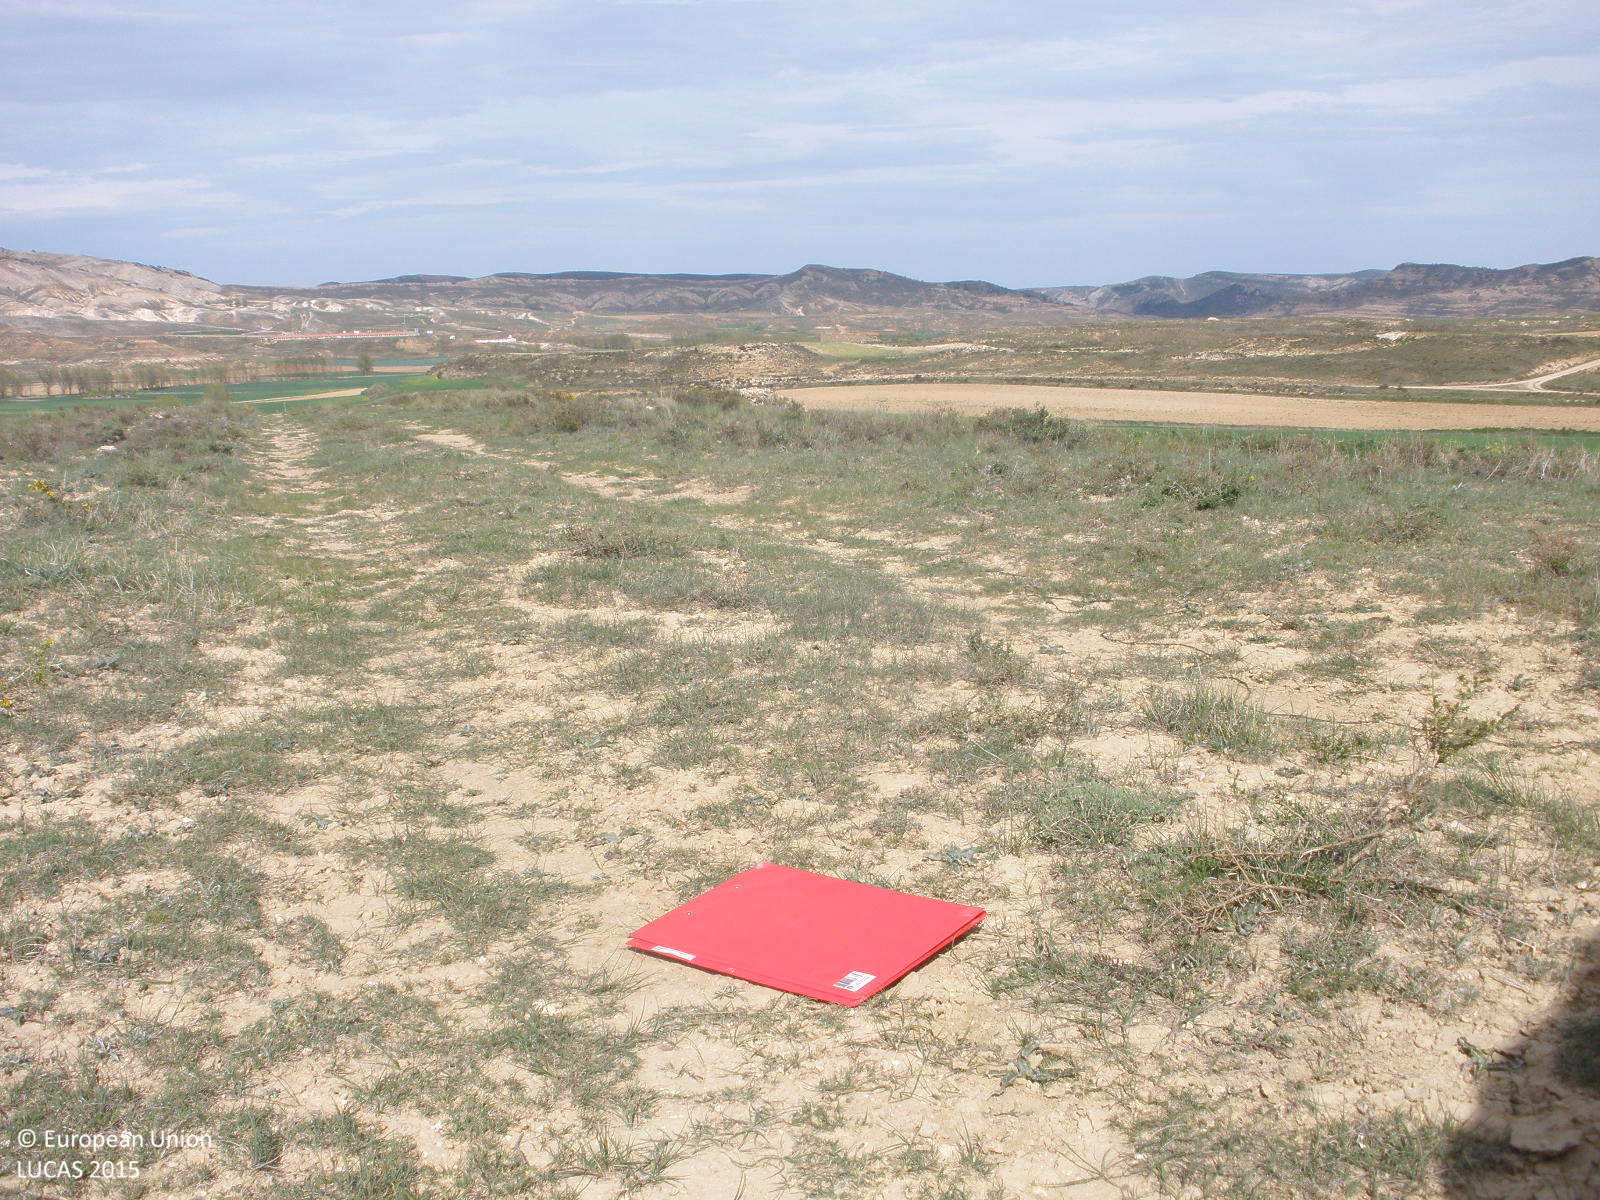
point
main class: Shrubland
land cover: Shrubland without tree cover
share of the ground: 25 - 50 %
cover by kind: herbaceous plants 50 %, shrubs 30 %, consolidated bare surface 20 %
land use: Semi-natural and natural areas not in use
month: May
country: ES
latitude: 40.6734
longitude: -0.7892
